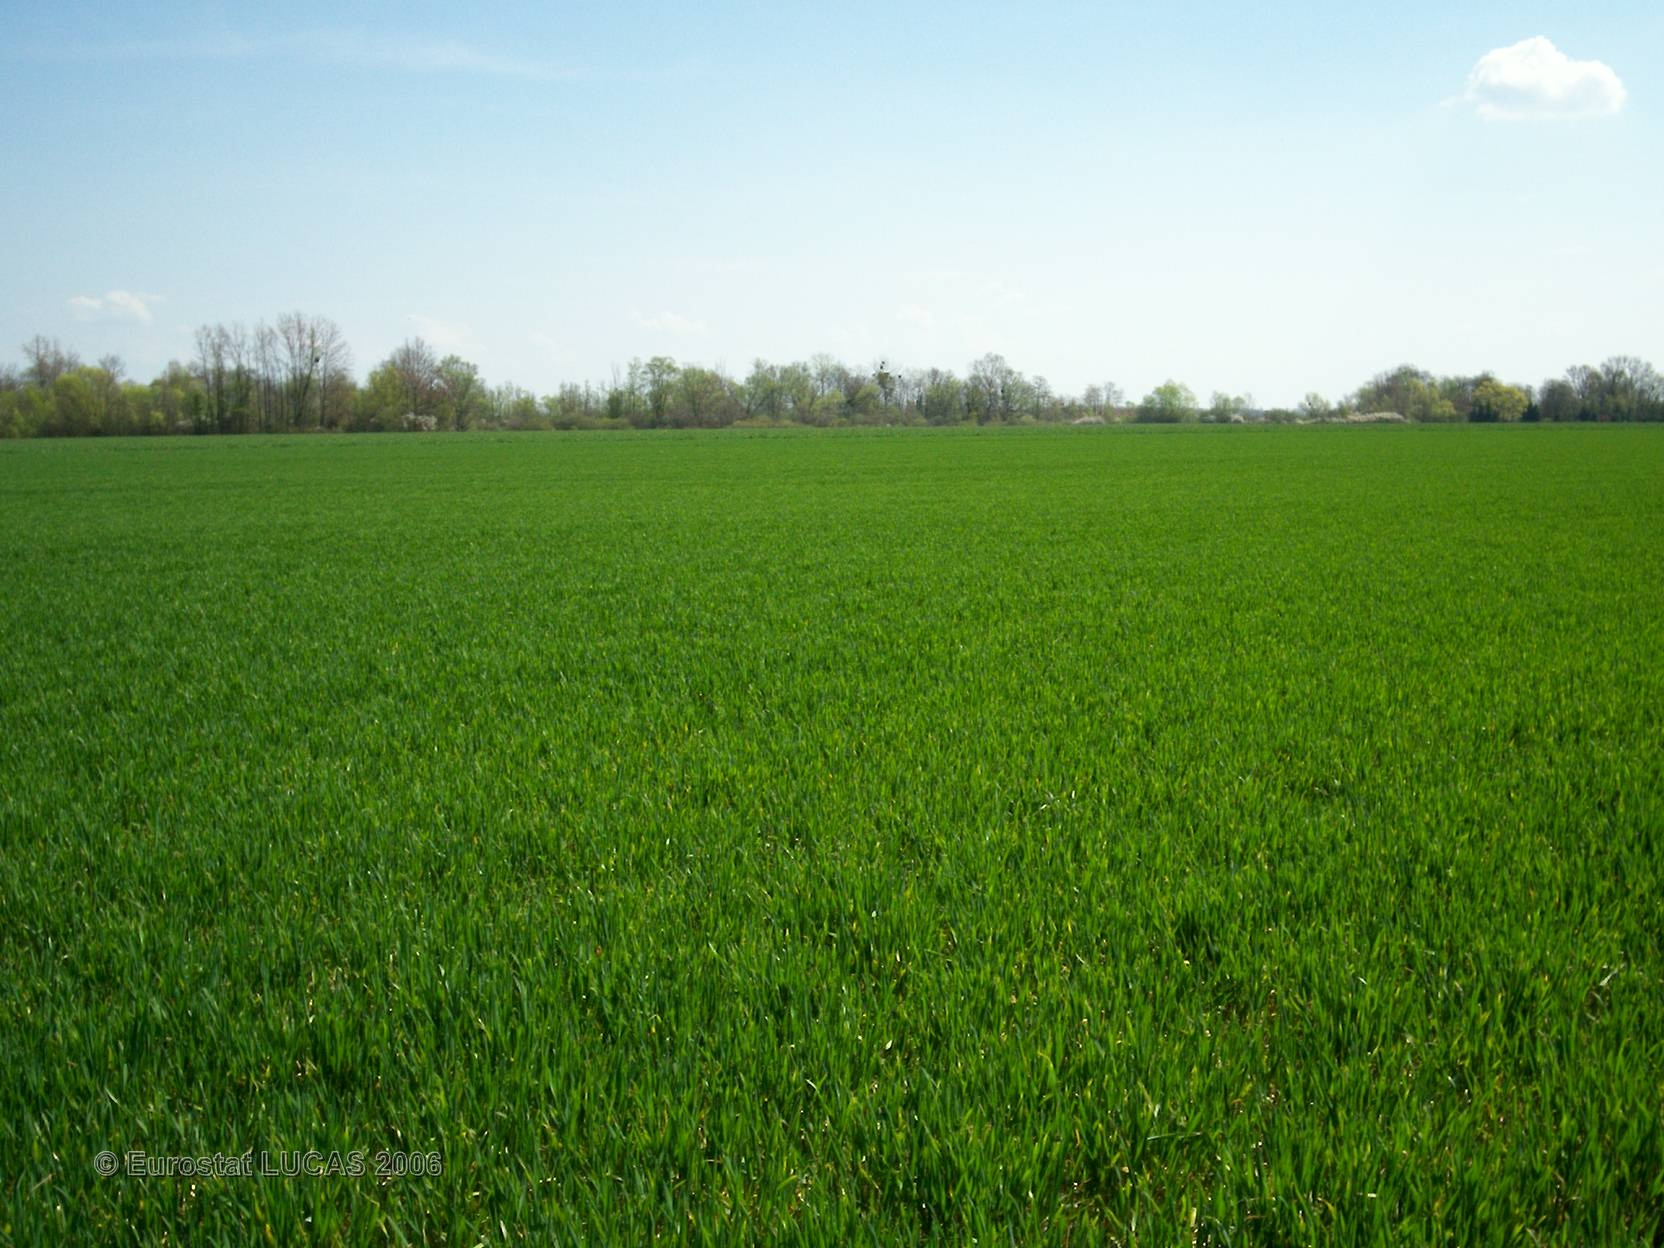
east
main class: Cropland
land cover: Common wheat
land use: Agriculture (excluding fallow land and kitchen gardens)
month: April
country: FR
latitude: 48.4122
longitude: 4.5257
